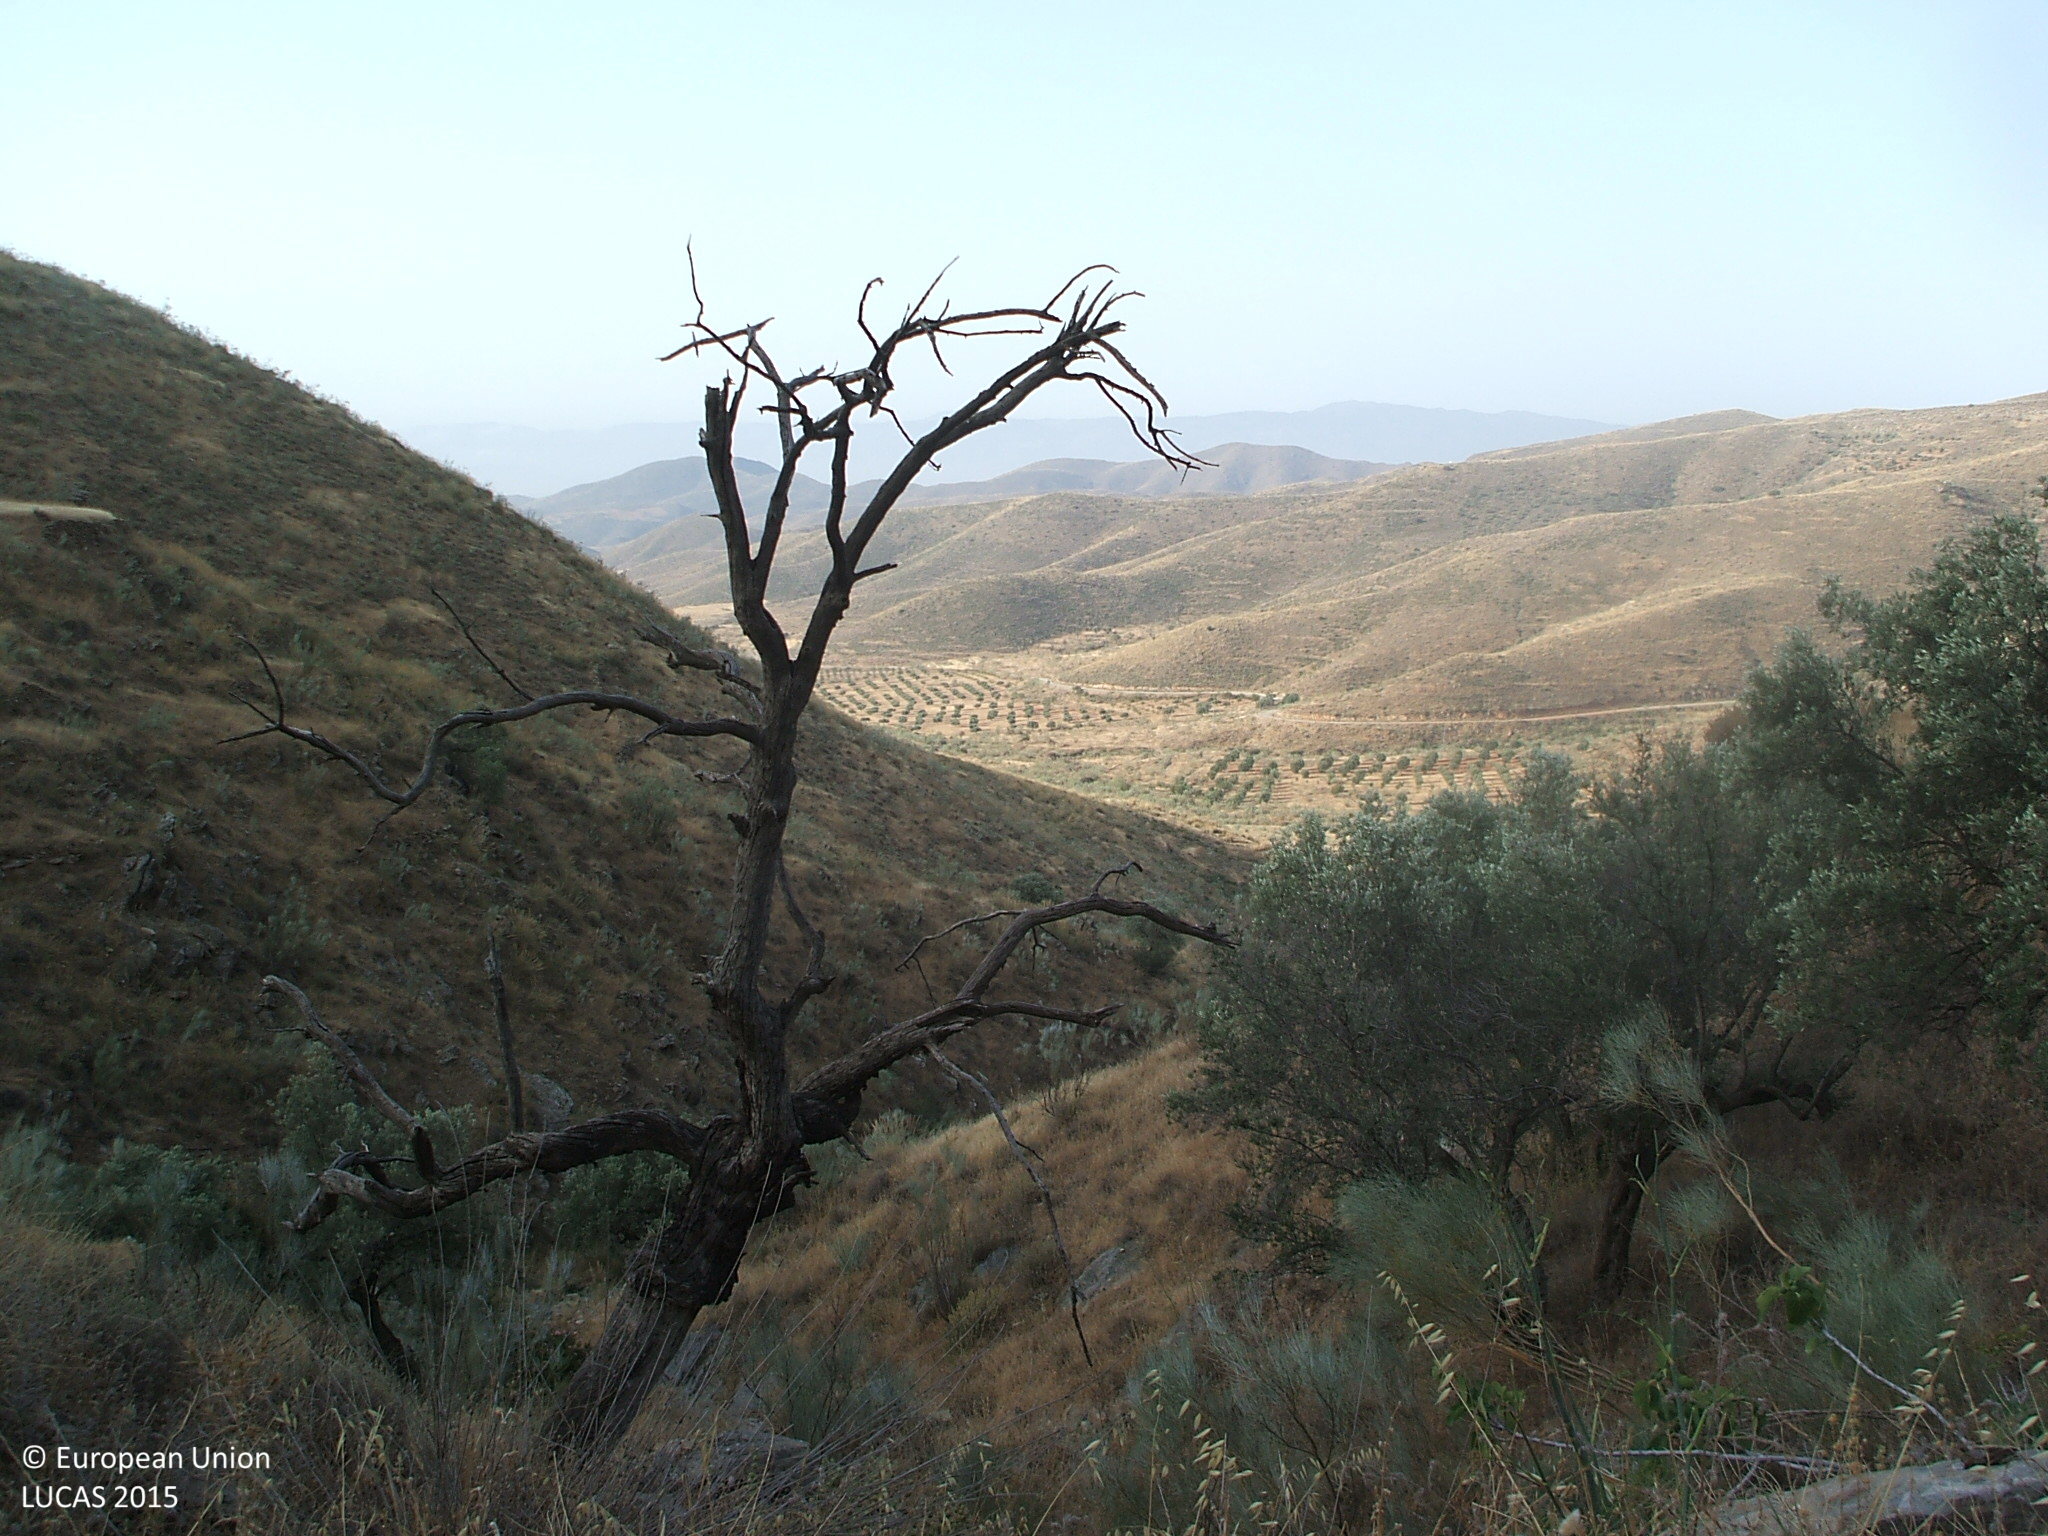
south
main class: Shrubland
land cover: Shrubland without tree cover
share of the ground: 25 - 50 %
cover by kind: lichens and mosses 40 %, shrubs 30 %, herbaceous plants 30 %
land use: Semi-natural and natural areas not in use
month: July
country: ES
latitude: 37.2060
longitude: -2.2722
